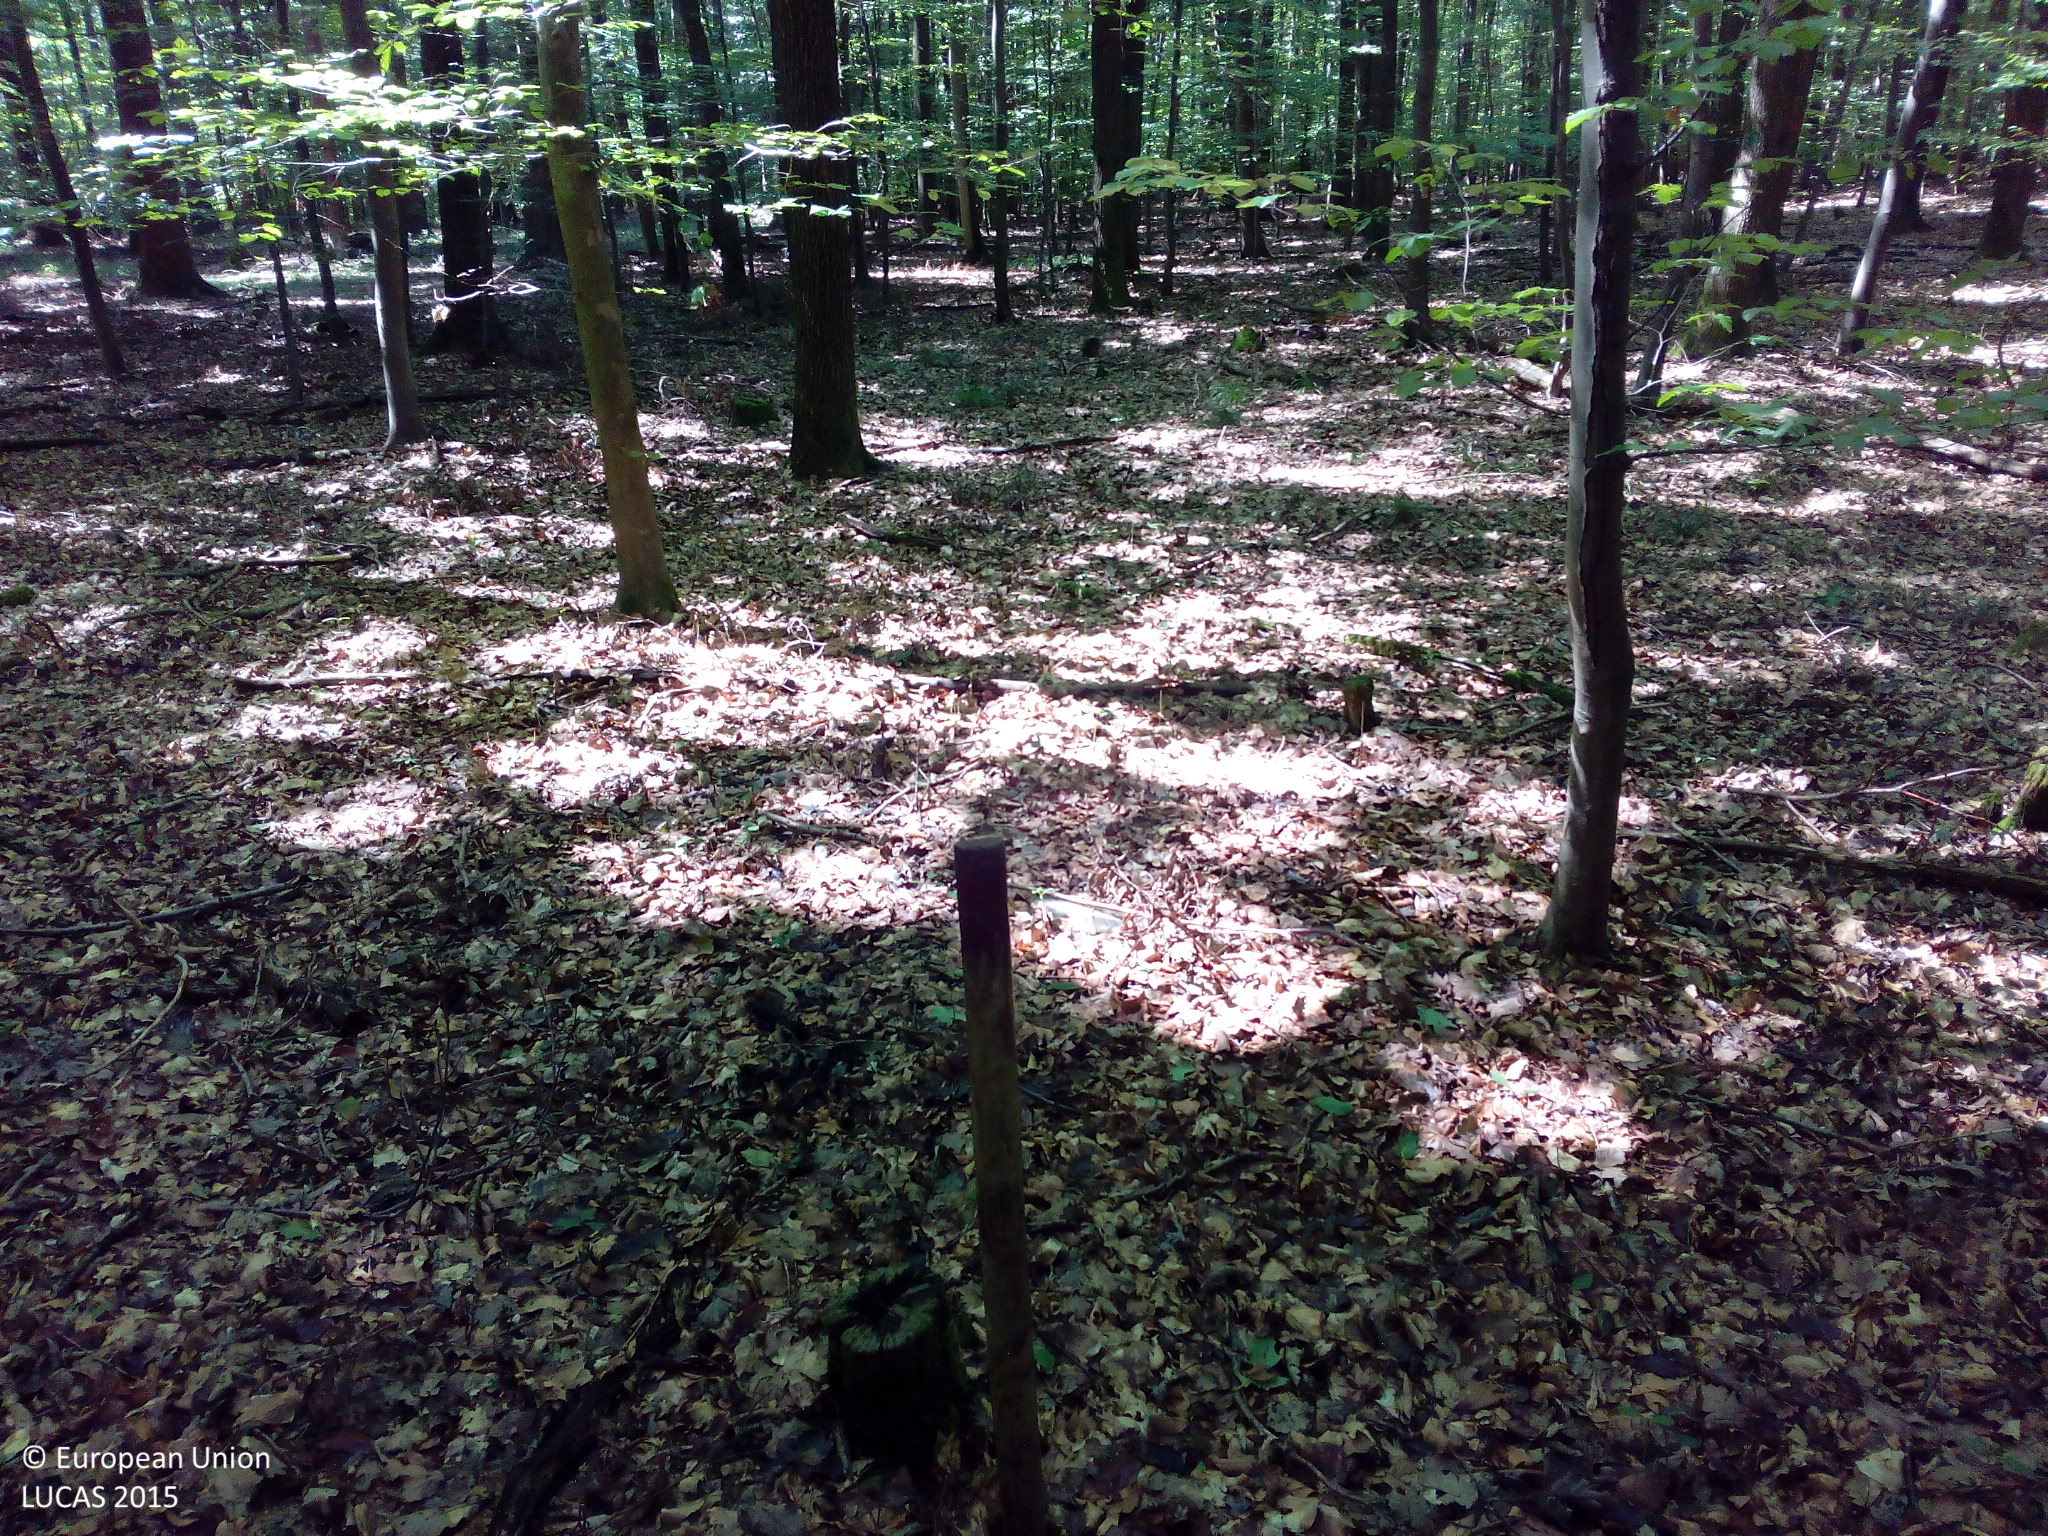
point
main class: Woodland
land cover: Broadleaved woodland
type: beech forest
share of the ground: > 75 %
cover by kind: broadleaved forest trees 80 %, coniferous forest trees 10 %, unconsolidated bare surface 10 %
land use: Forestry
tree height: > 5 m
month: August
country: DE
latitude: 48.9880
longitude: 8.5657
